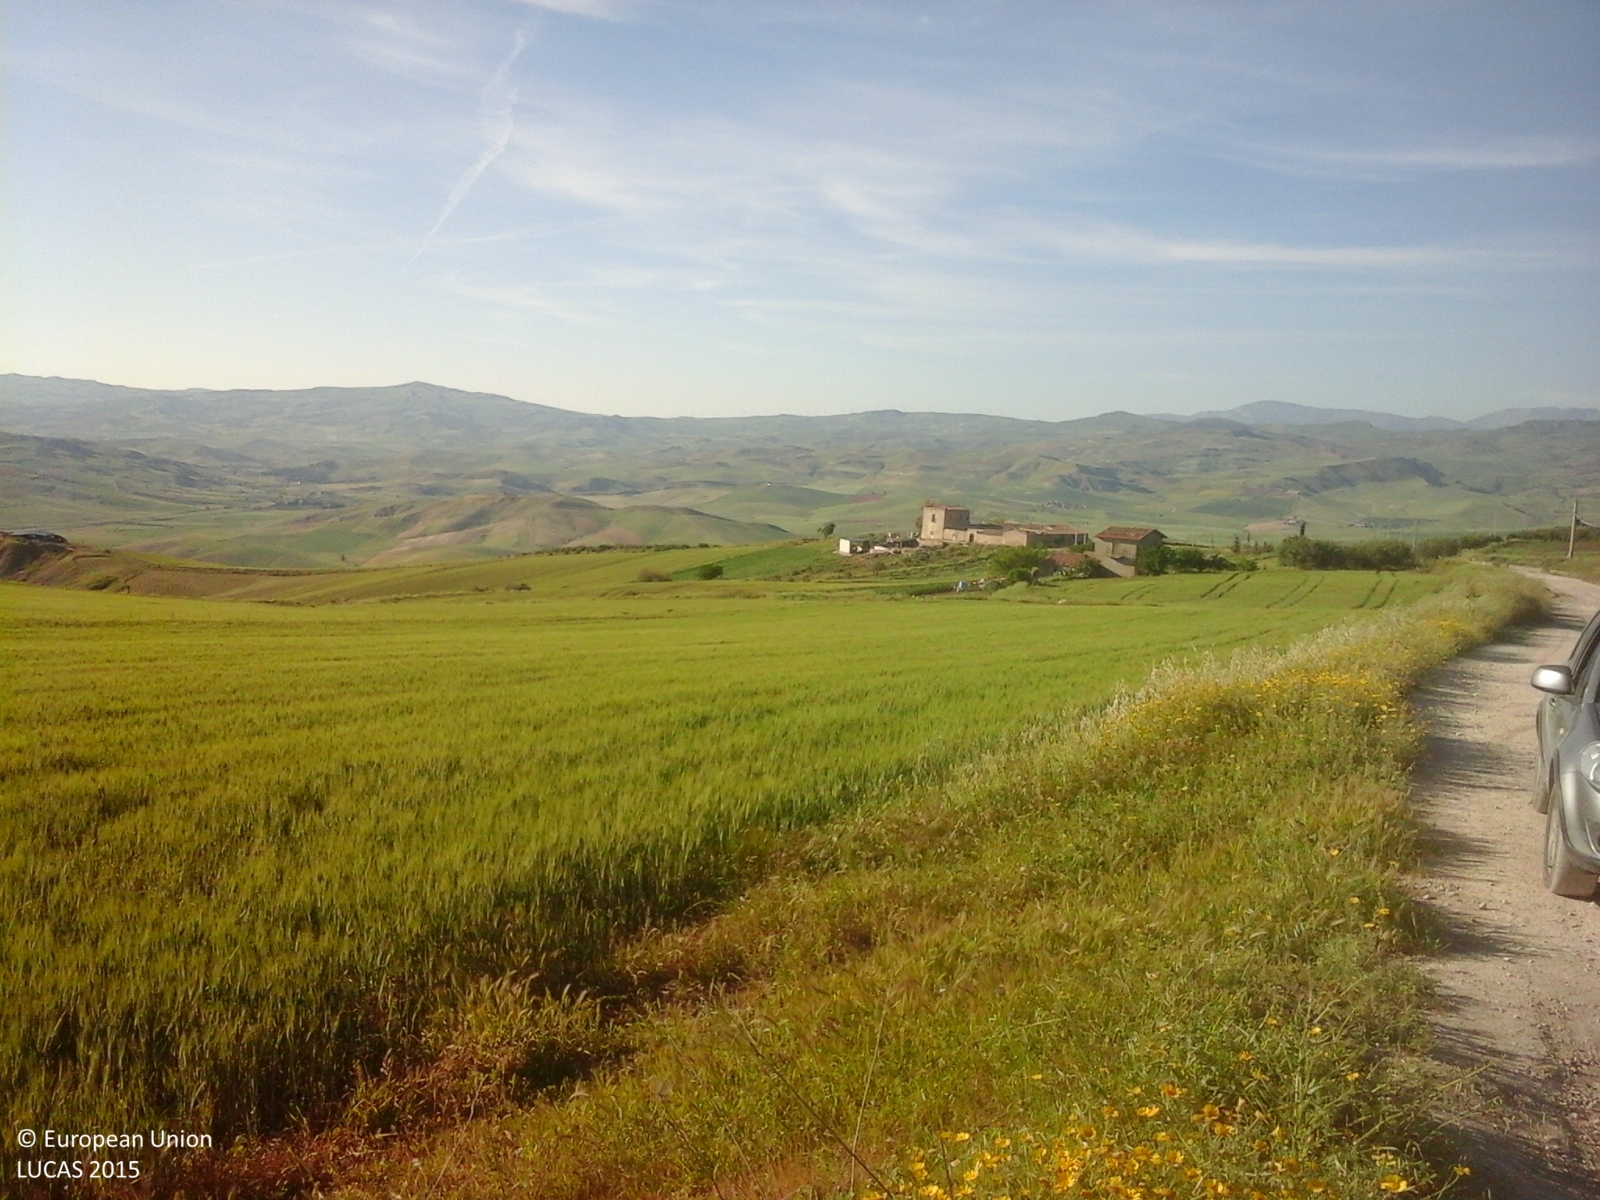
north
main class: Cropland
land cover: Durum wheat
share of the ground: > 75 %
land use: Agriculture (excluding fallow land and kitchen gardens)
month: May
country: IT
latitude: 37.6120
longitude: 13.9246
